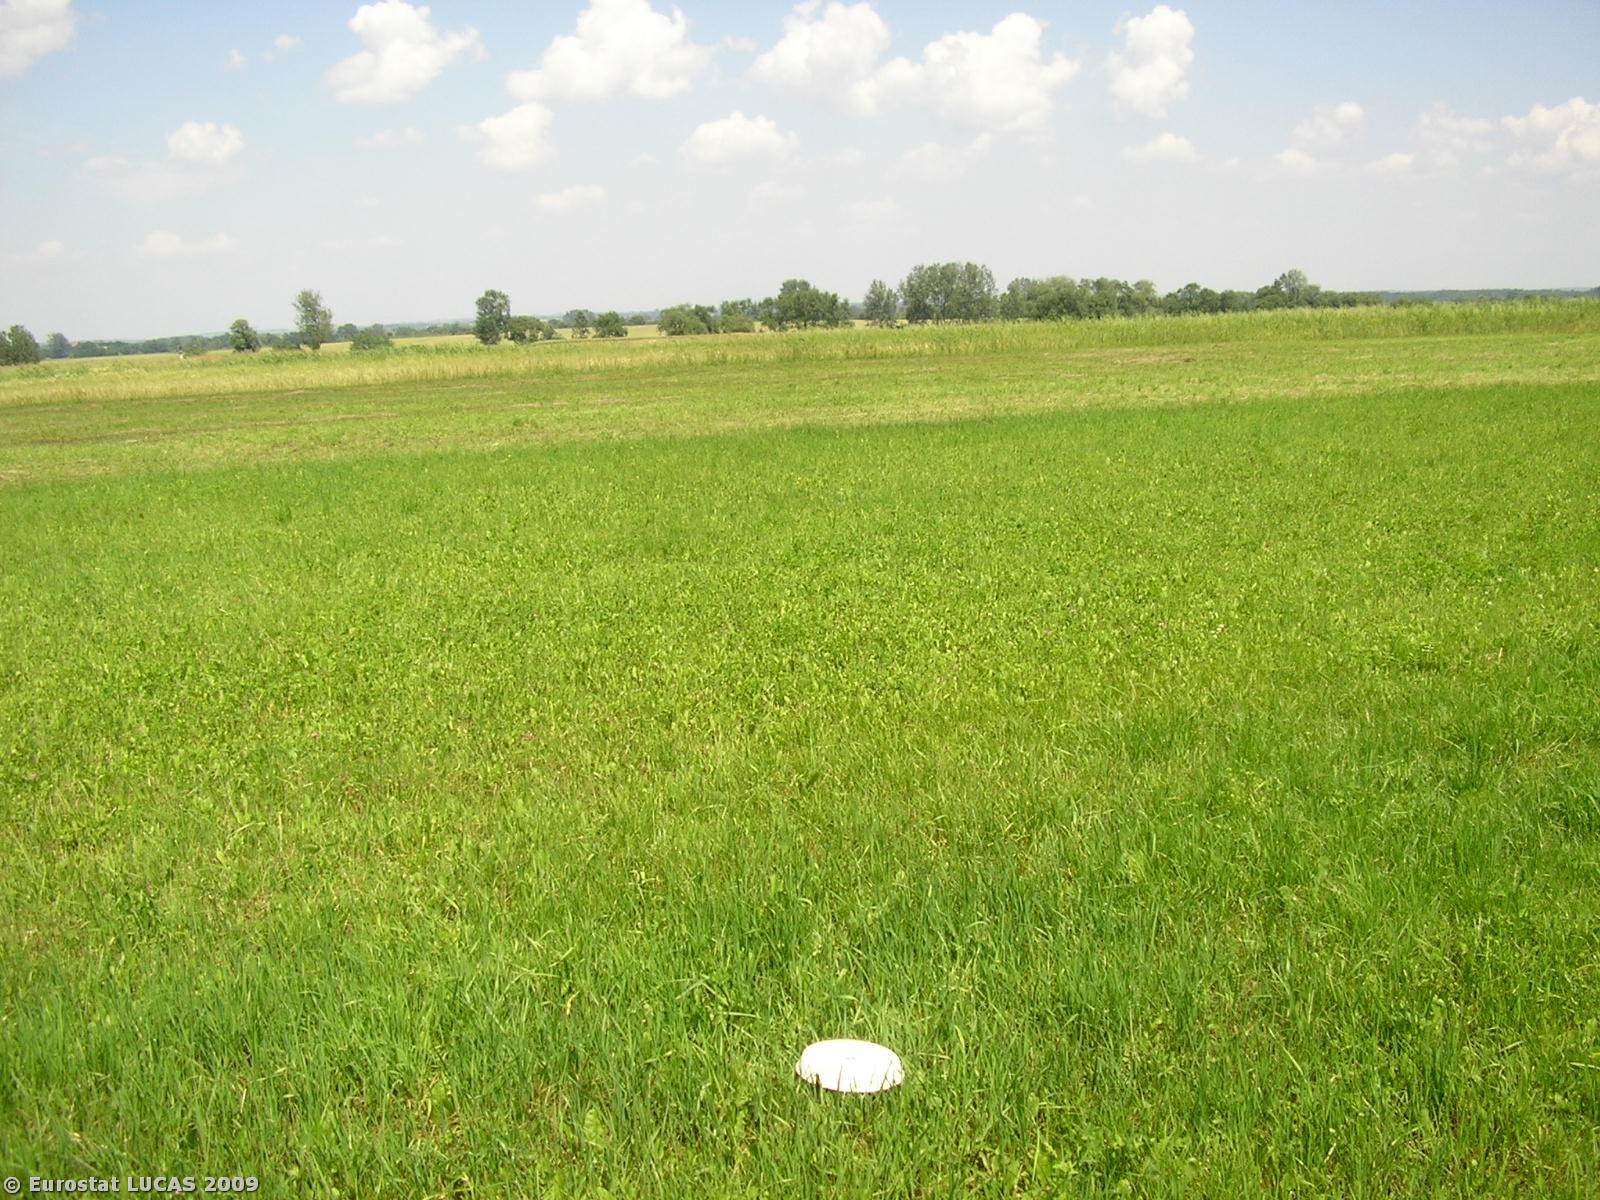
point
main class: Grassland
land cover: Grassland without tree/shrub cover
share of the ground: > 75 %
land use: Agriculture (excluding fallow land and kitchen gardens)
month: July
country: PL
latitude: 50.3498
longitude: 20.7070
